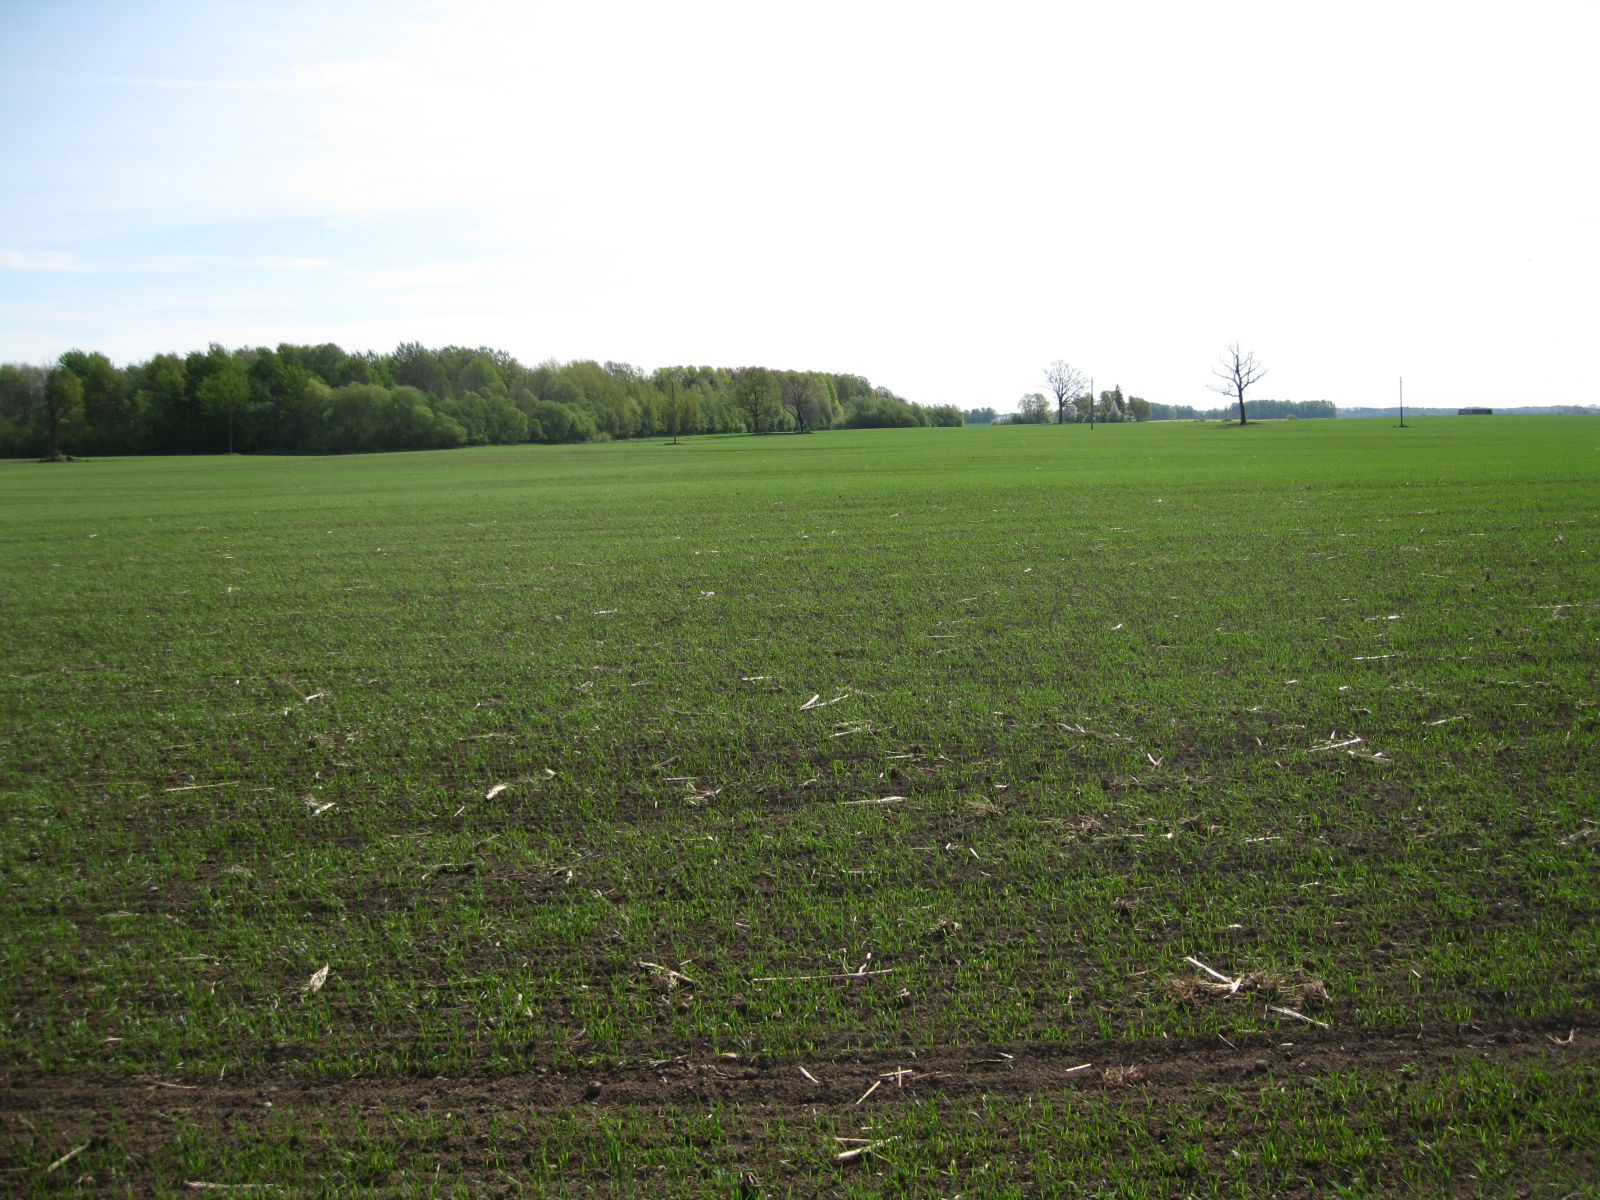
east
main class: Cropland
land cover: Common wheat
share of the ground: < 10 %
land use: Agriculture (excluding fallow land and kitchen gardens)
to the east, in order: Common wheat; Electric lines; Common wheat
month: May
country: LT
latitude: 56.1769
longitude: 24.2183
